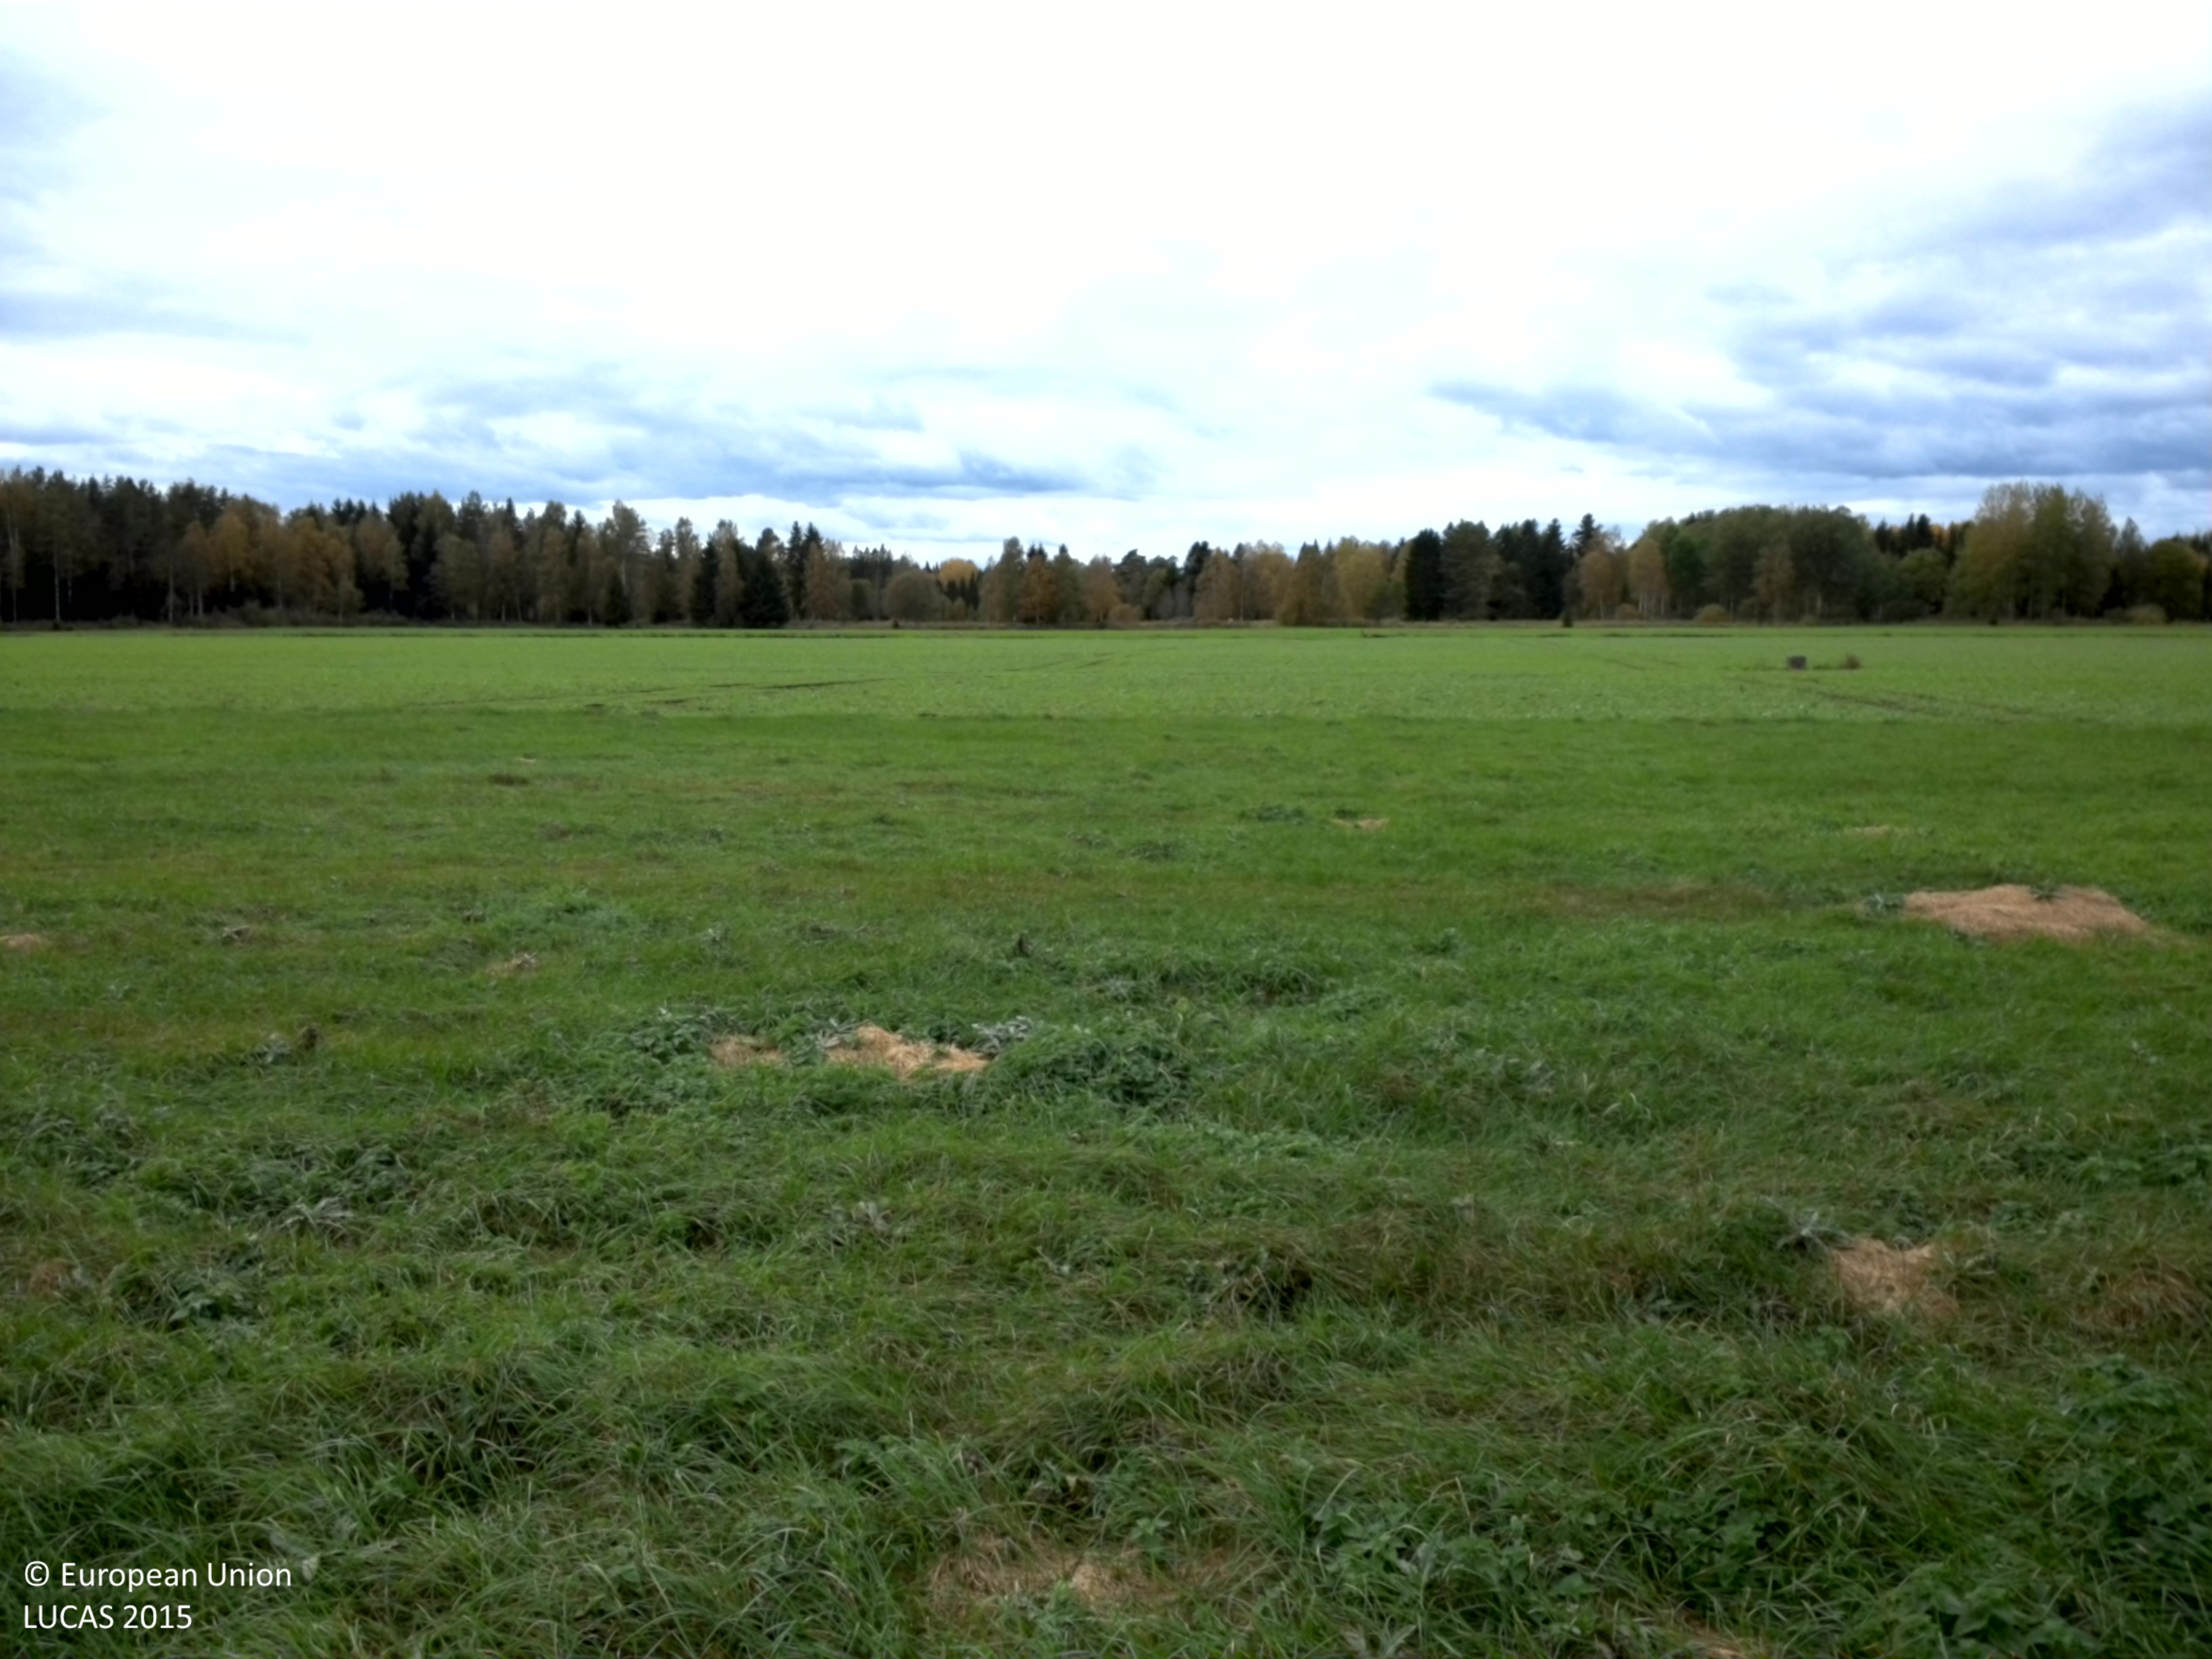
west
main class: Grassland
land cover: Grassland without tree/shrub cover
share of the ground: > 75 %
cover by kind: herbaceous plants 100 %
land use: Agriculture (excluding fallow land and kitchen gardens)
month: September
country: SE
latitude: 60.1874
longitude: 17.0054
